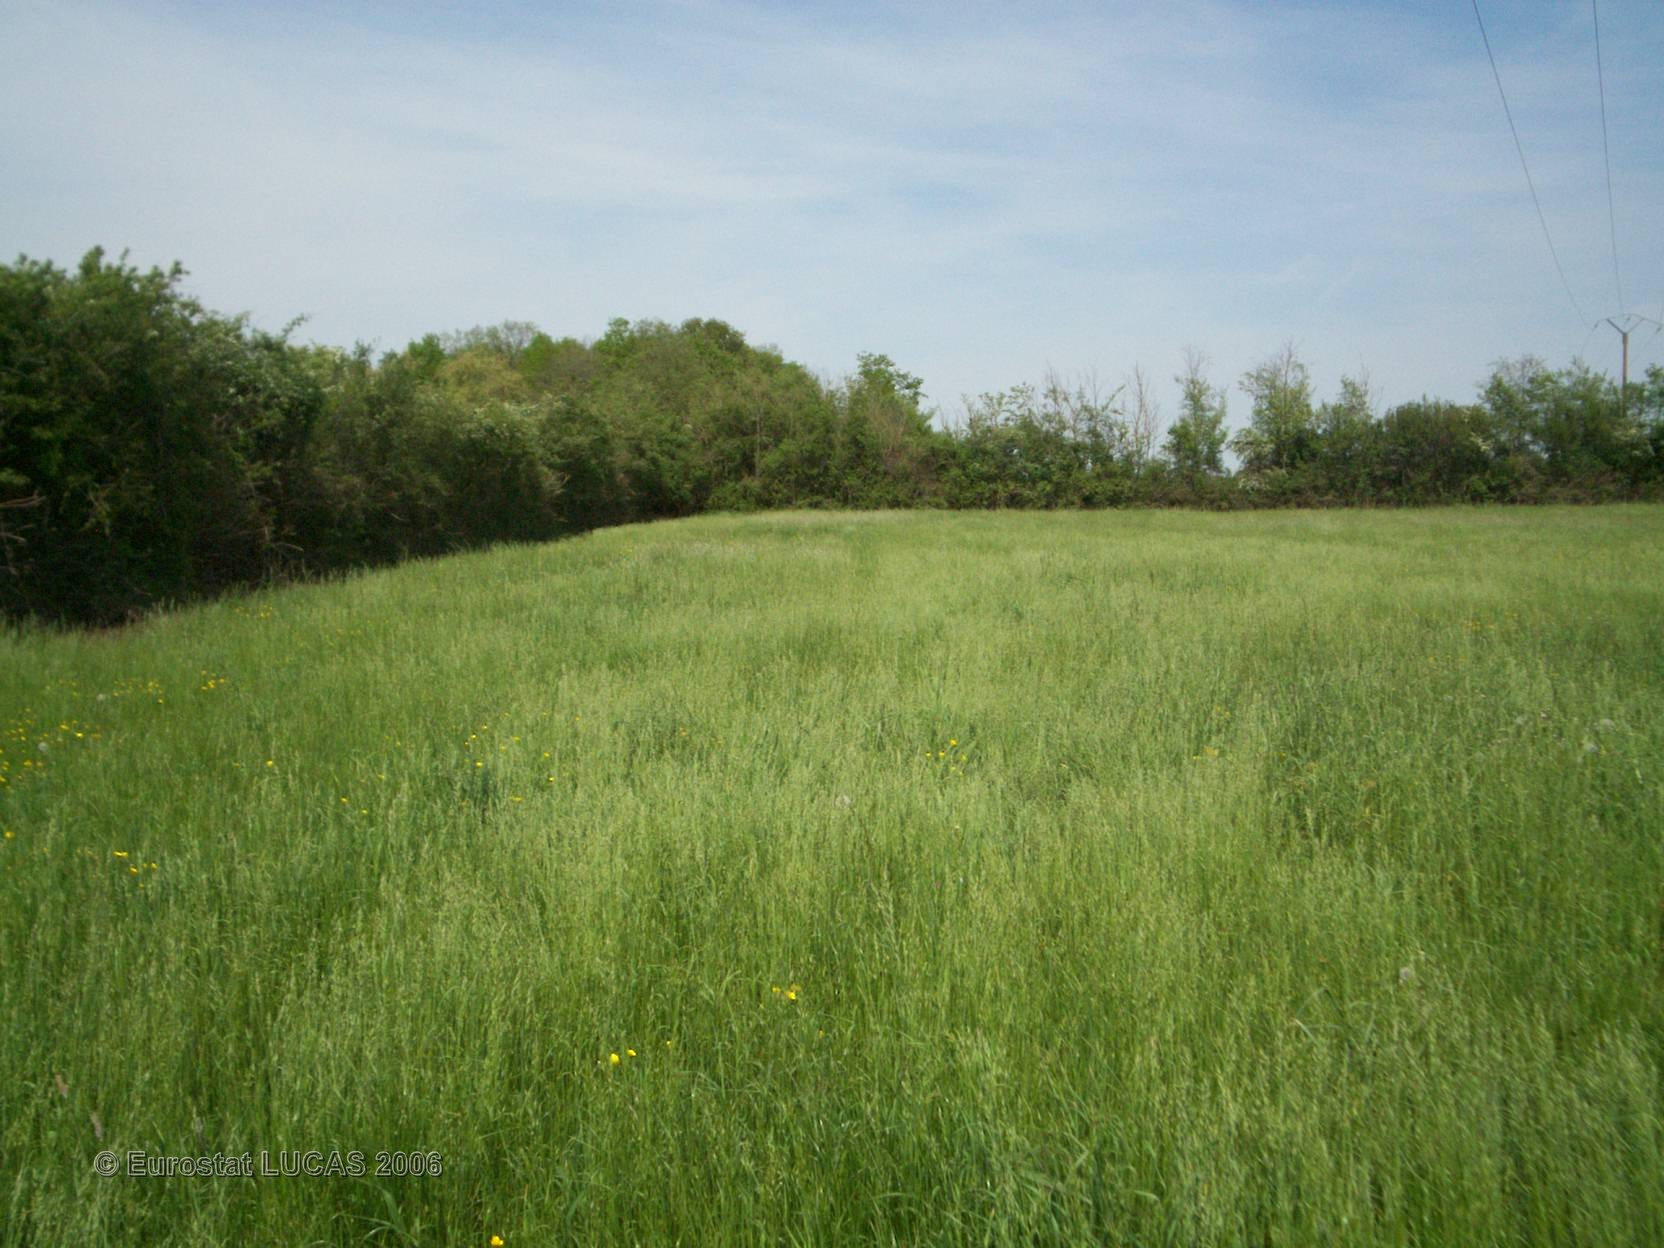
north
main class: Grassland
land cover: Grassland without tree/shrub cover
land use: Agriculture (excluding fallow land and kitchen gardens)
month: May
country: FR
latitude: 47.3272
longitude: 0.5452
